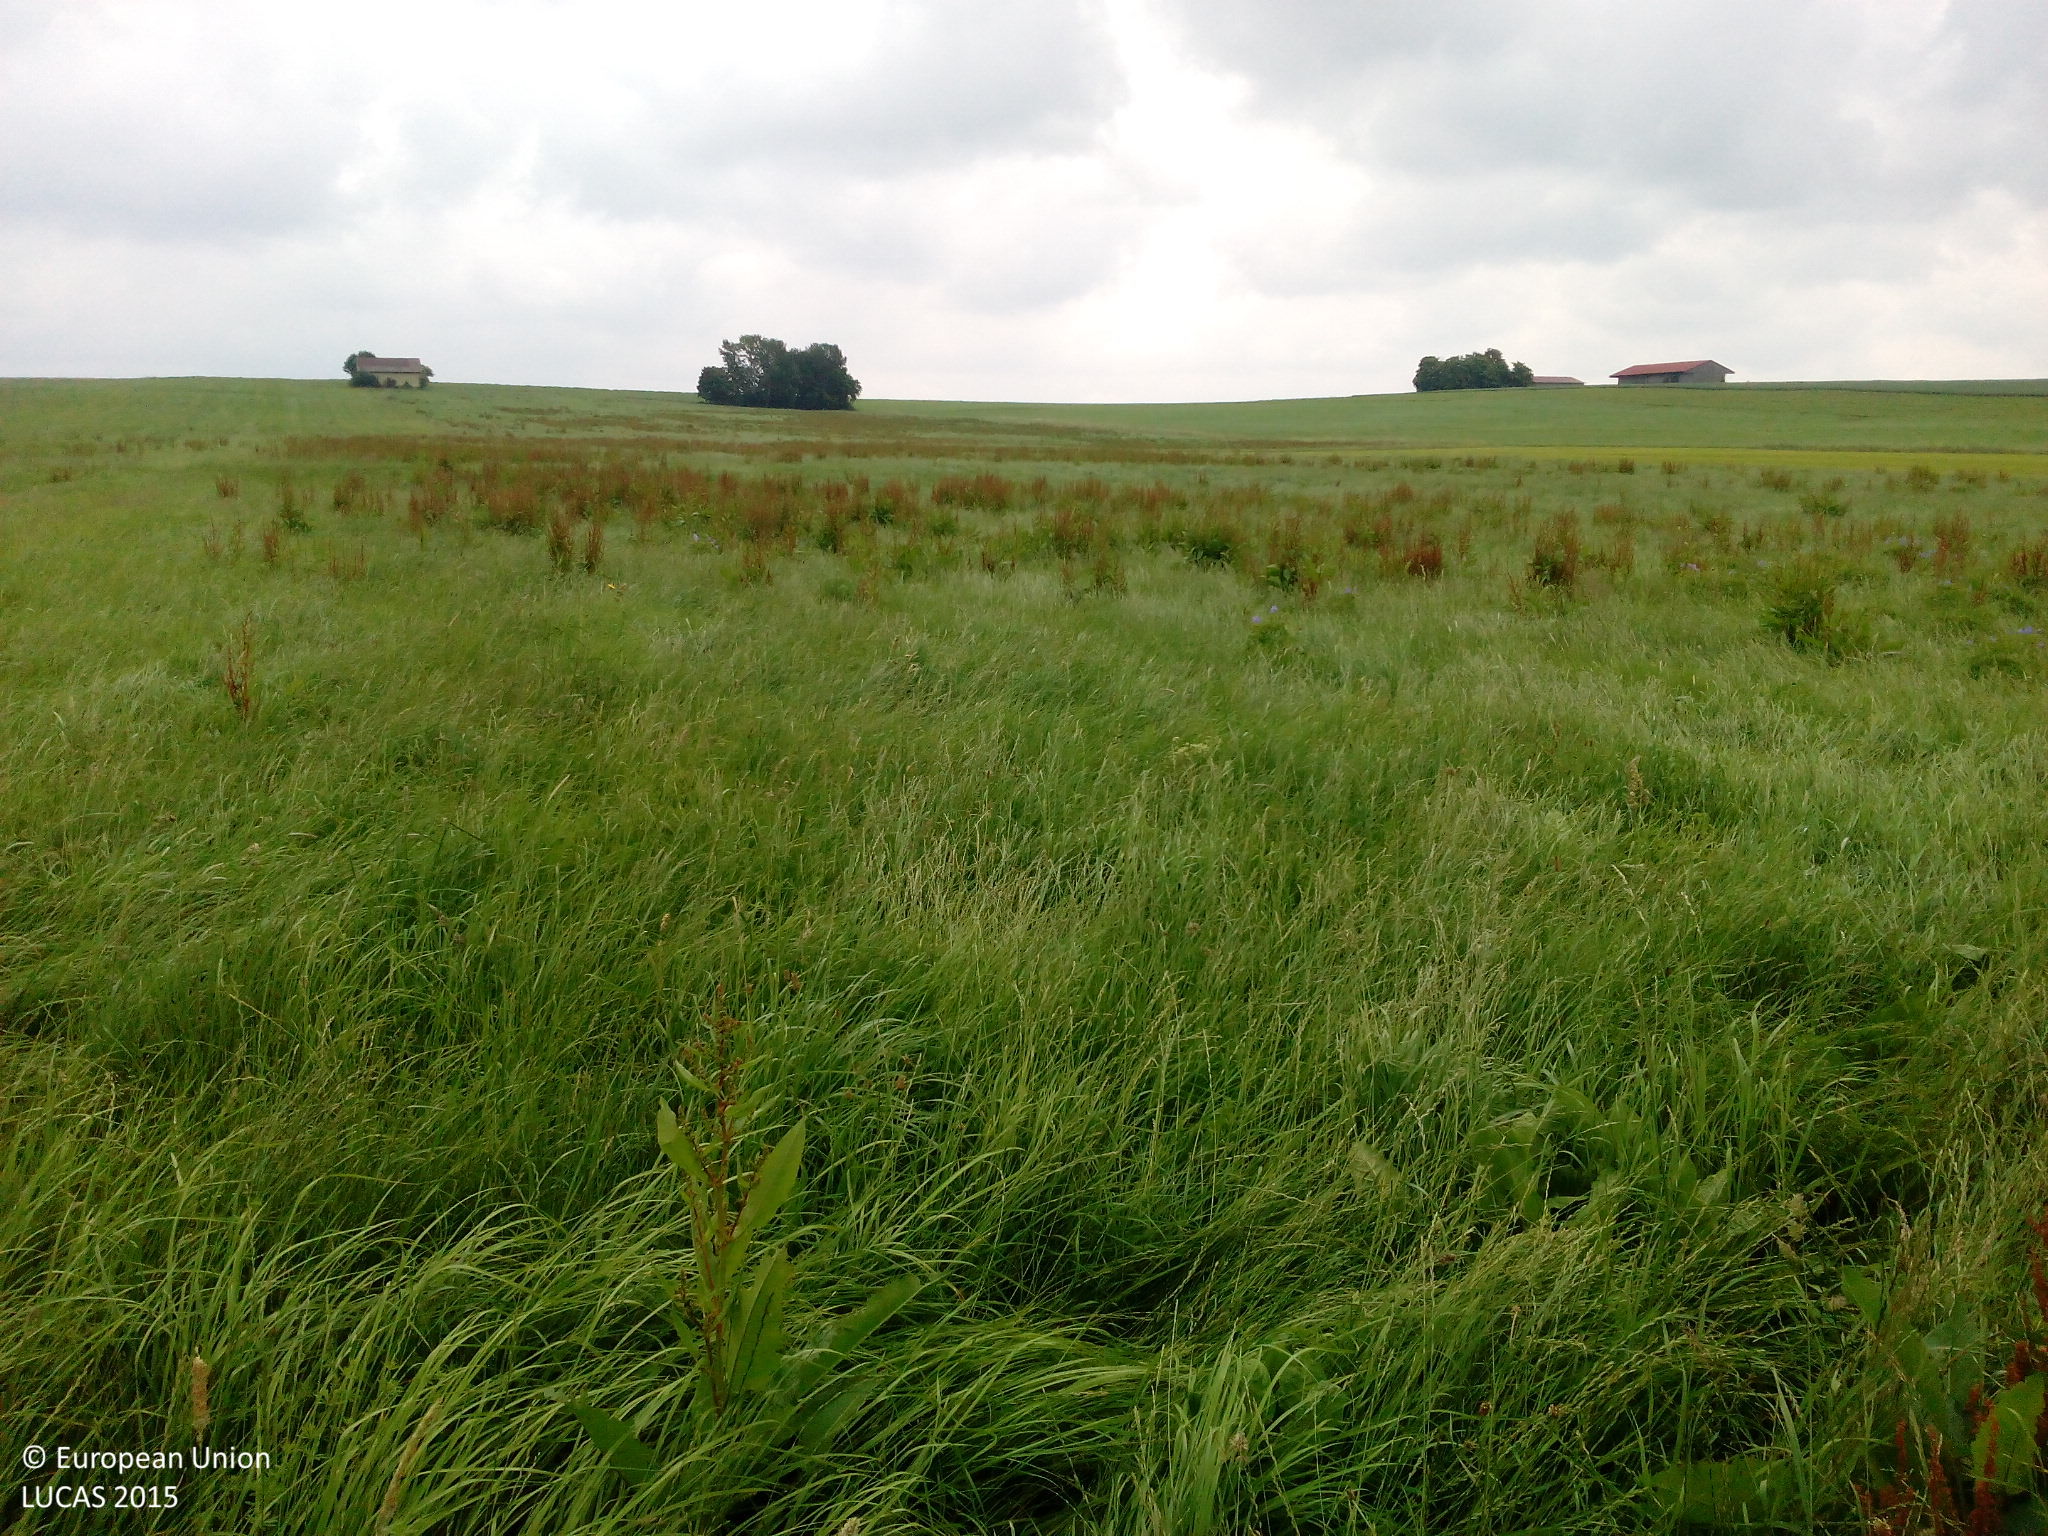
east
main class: Grassland
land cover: Grassland without tree/shrub cover
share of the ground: > 75 %
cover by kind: herbaceous plants 90 %, unconsolidated bare surface 10 %
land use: Agriculture (excluding fallow land and kitchen gardens)
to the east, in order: Grassland without tree/shrub cover
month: June
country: DE
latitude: 49.0656
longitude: 10.8893
